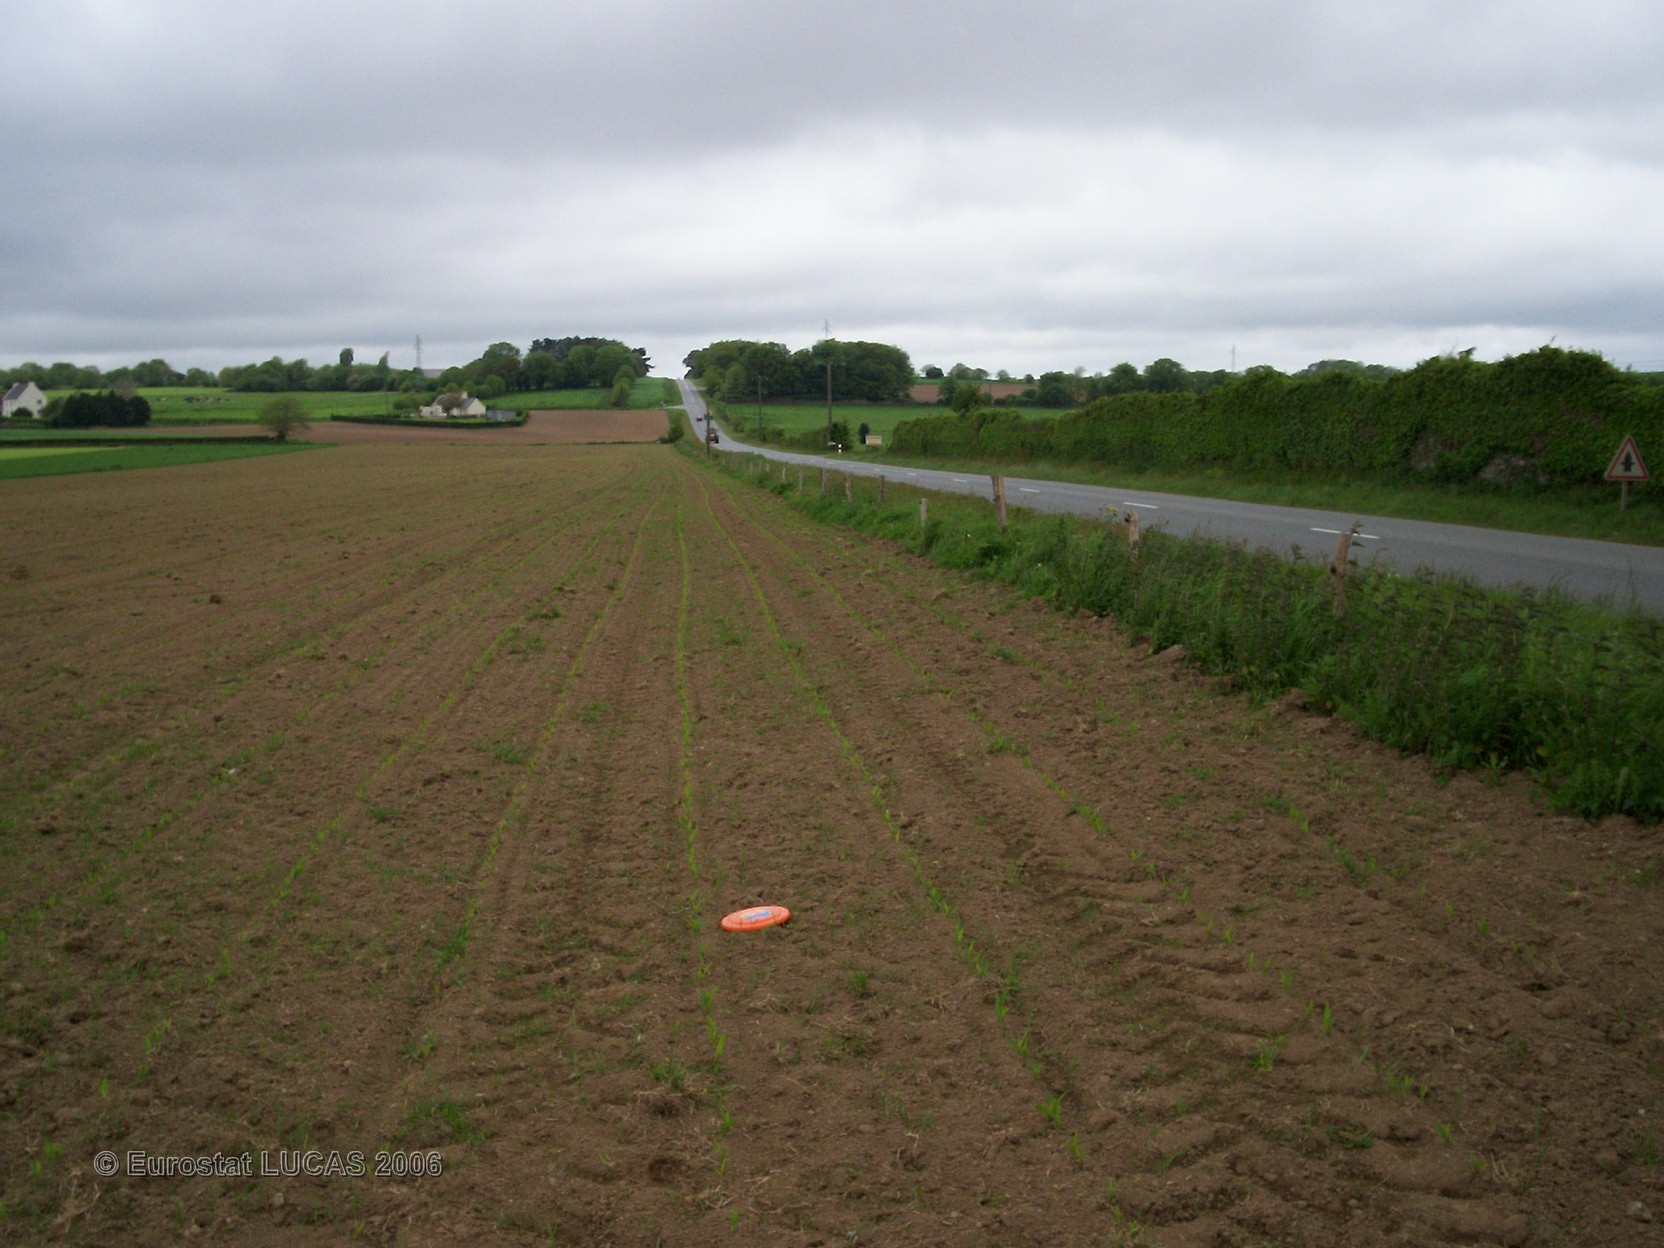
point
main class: Cropland
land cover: Maize
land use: Agriculture (excluding fallow land and kitchen gardens)
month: May
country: FR
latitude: 48.6235
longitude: -3.6905
